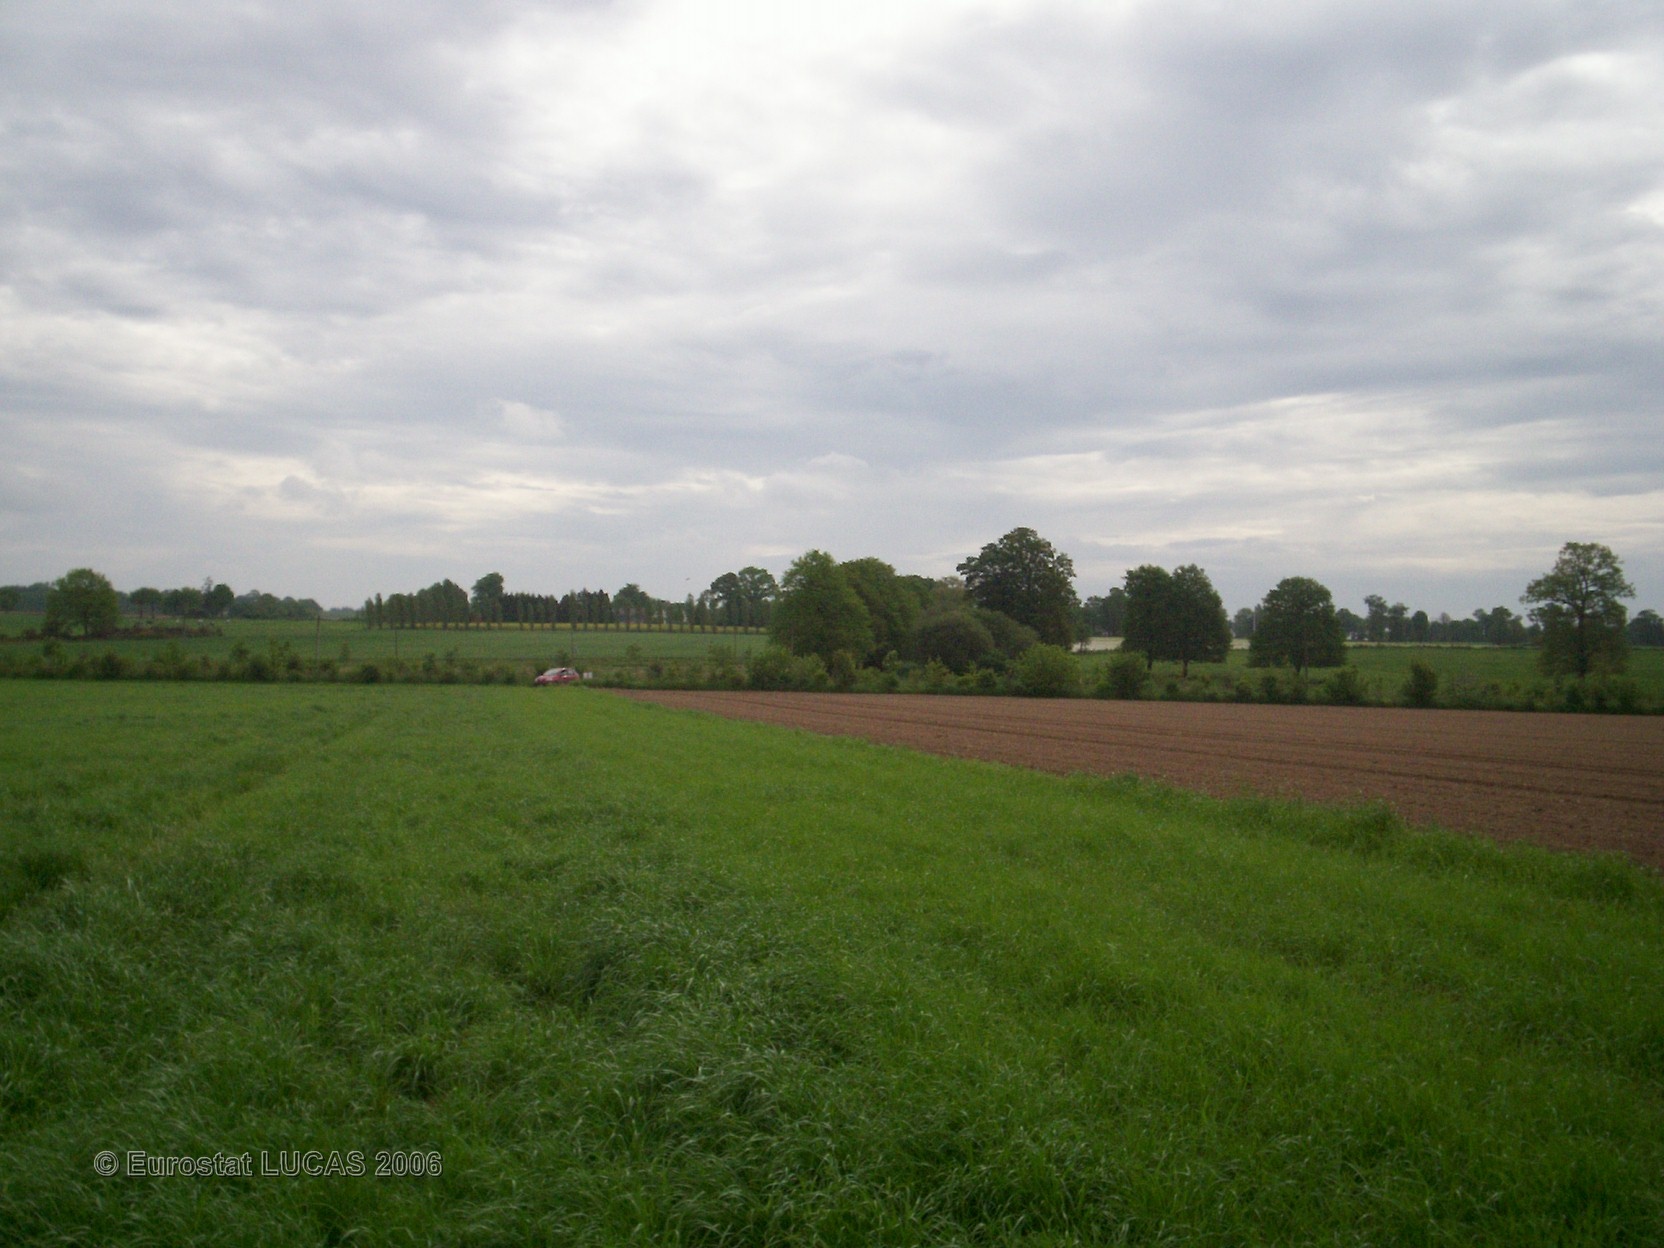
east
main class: Grassland
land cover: Grassland without tree/shrub cover
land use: Agriculture (excluding fallow land and kitchen gardens)
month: May
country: FR
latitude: 47.8519
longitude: -2.3654
